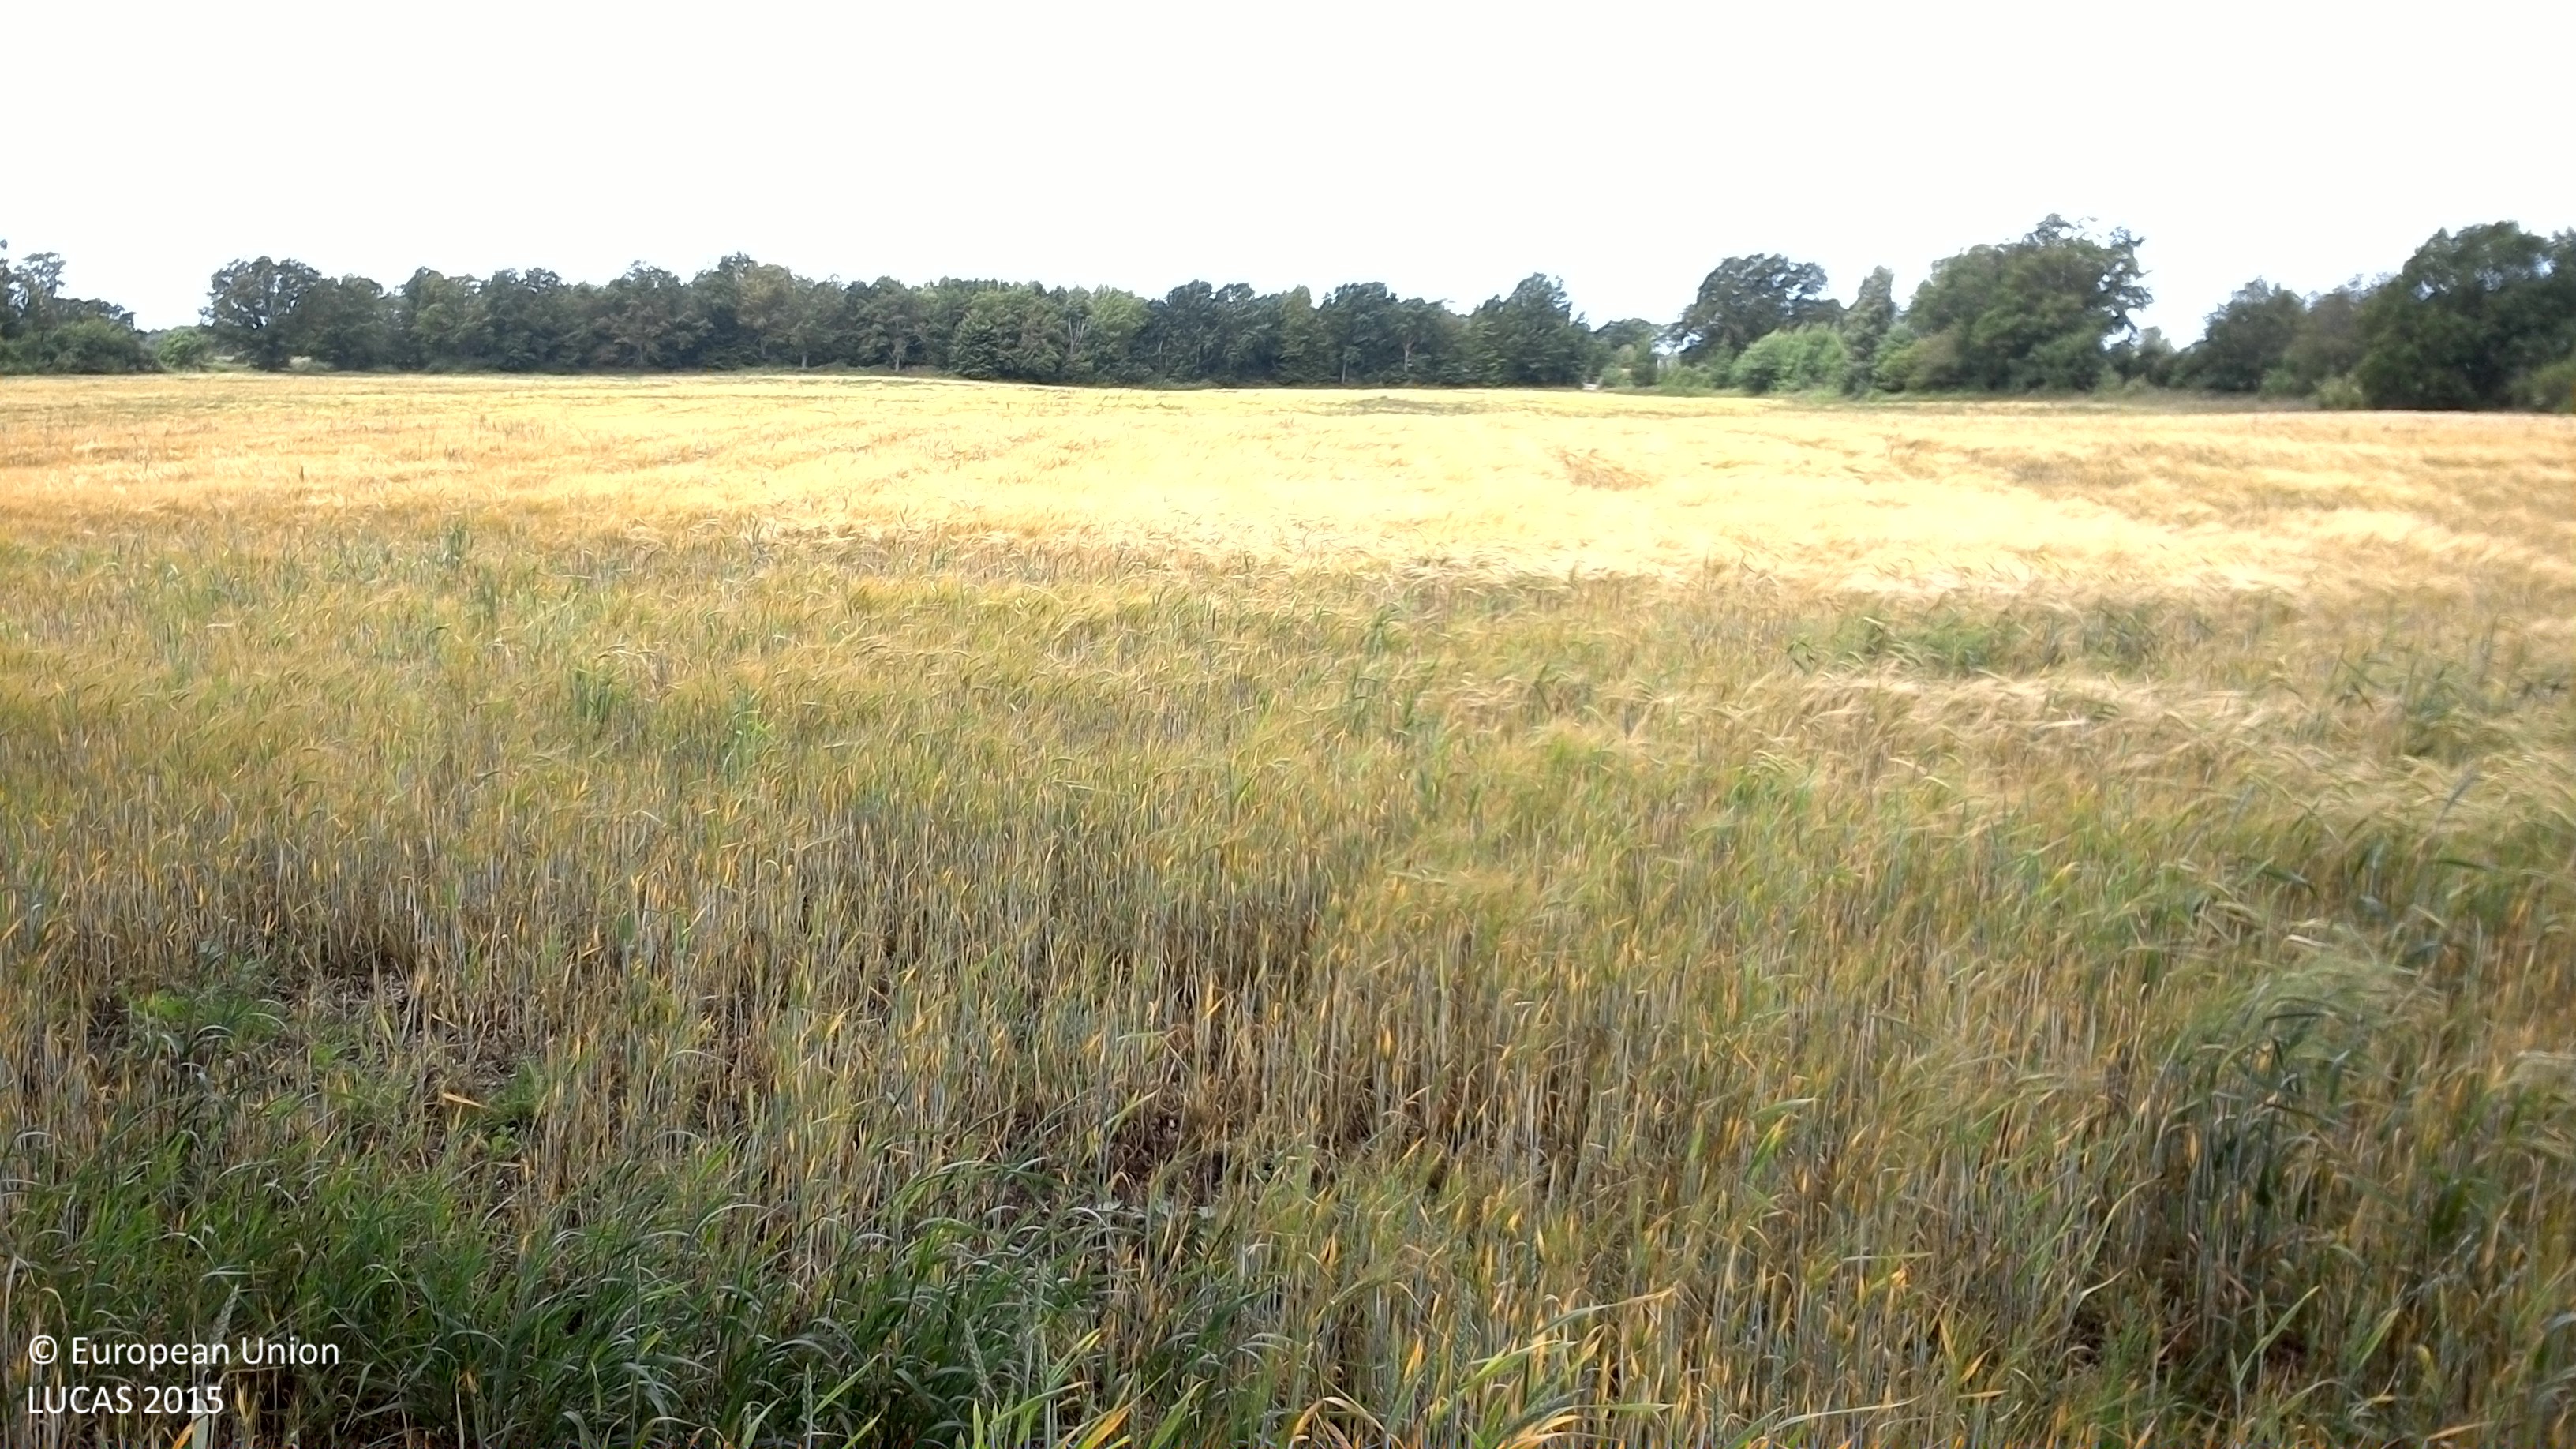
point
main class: Cropland
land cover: Rye
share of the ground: > 75 %
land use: Agriculture (excluding fallow land and kitchen gardens)
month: June
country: SE
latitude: 56.4567
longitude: 16.1182
